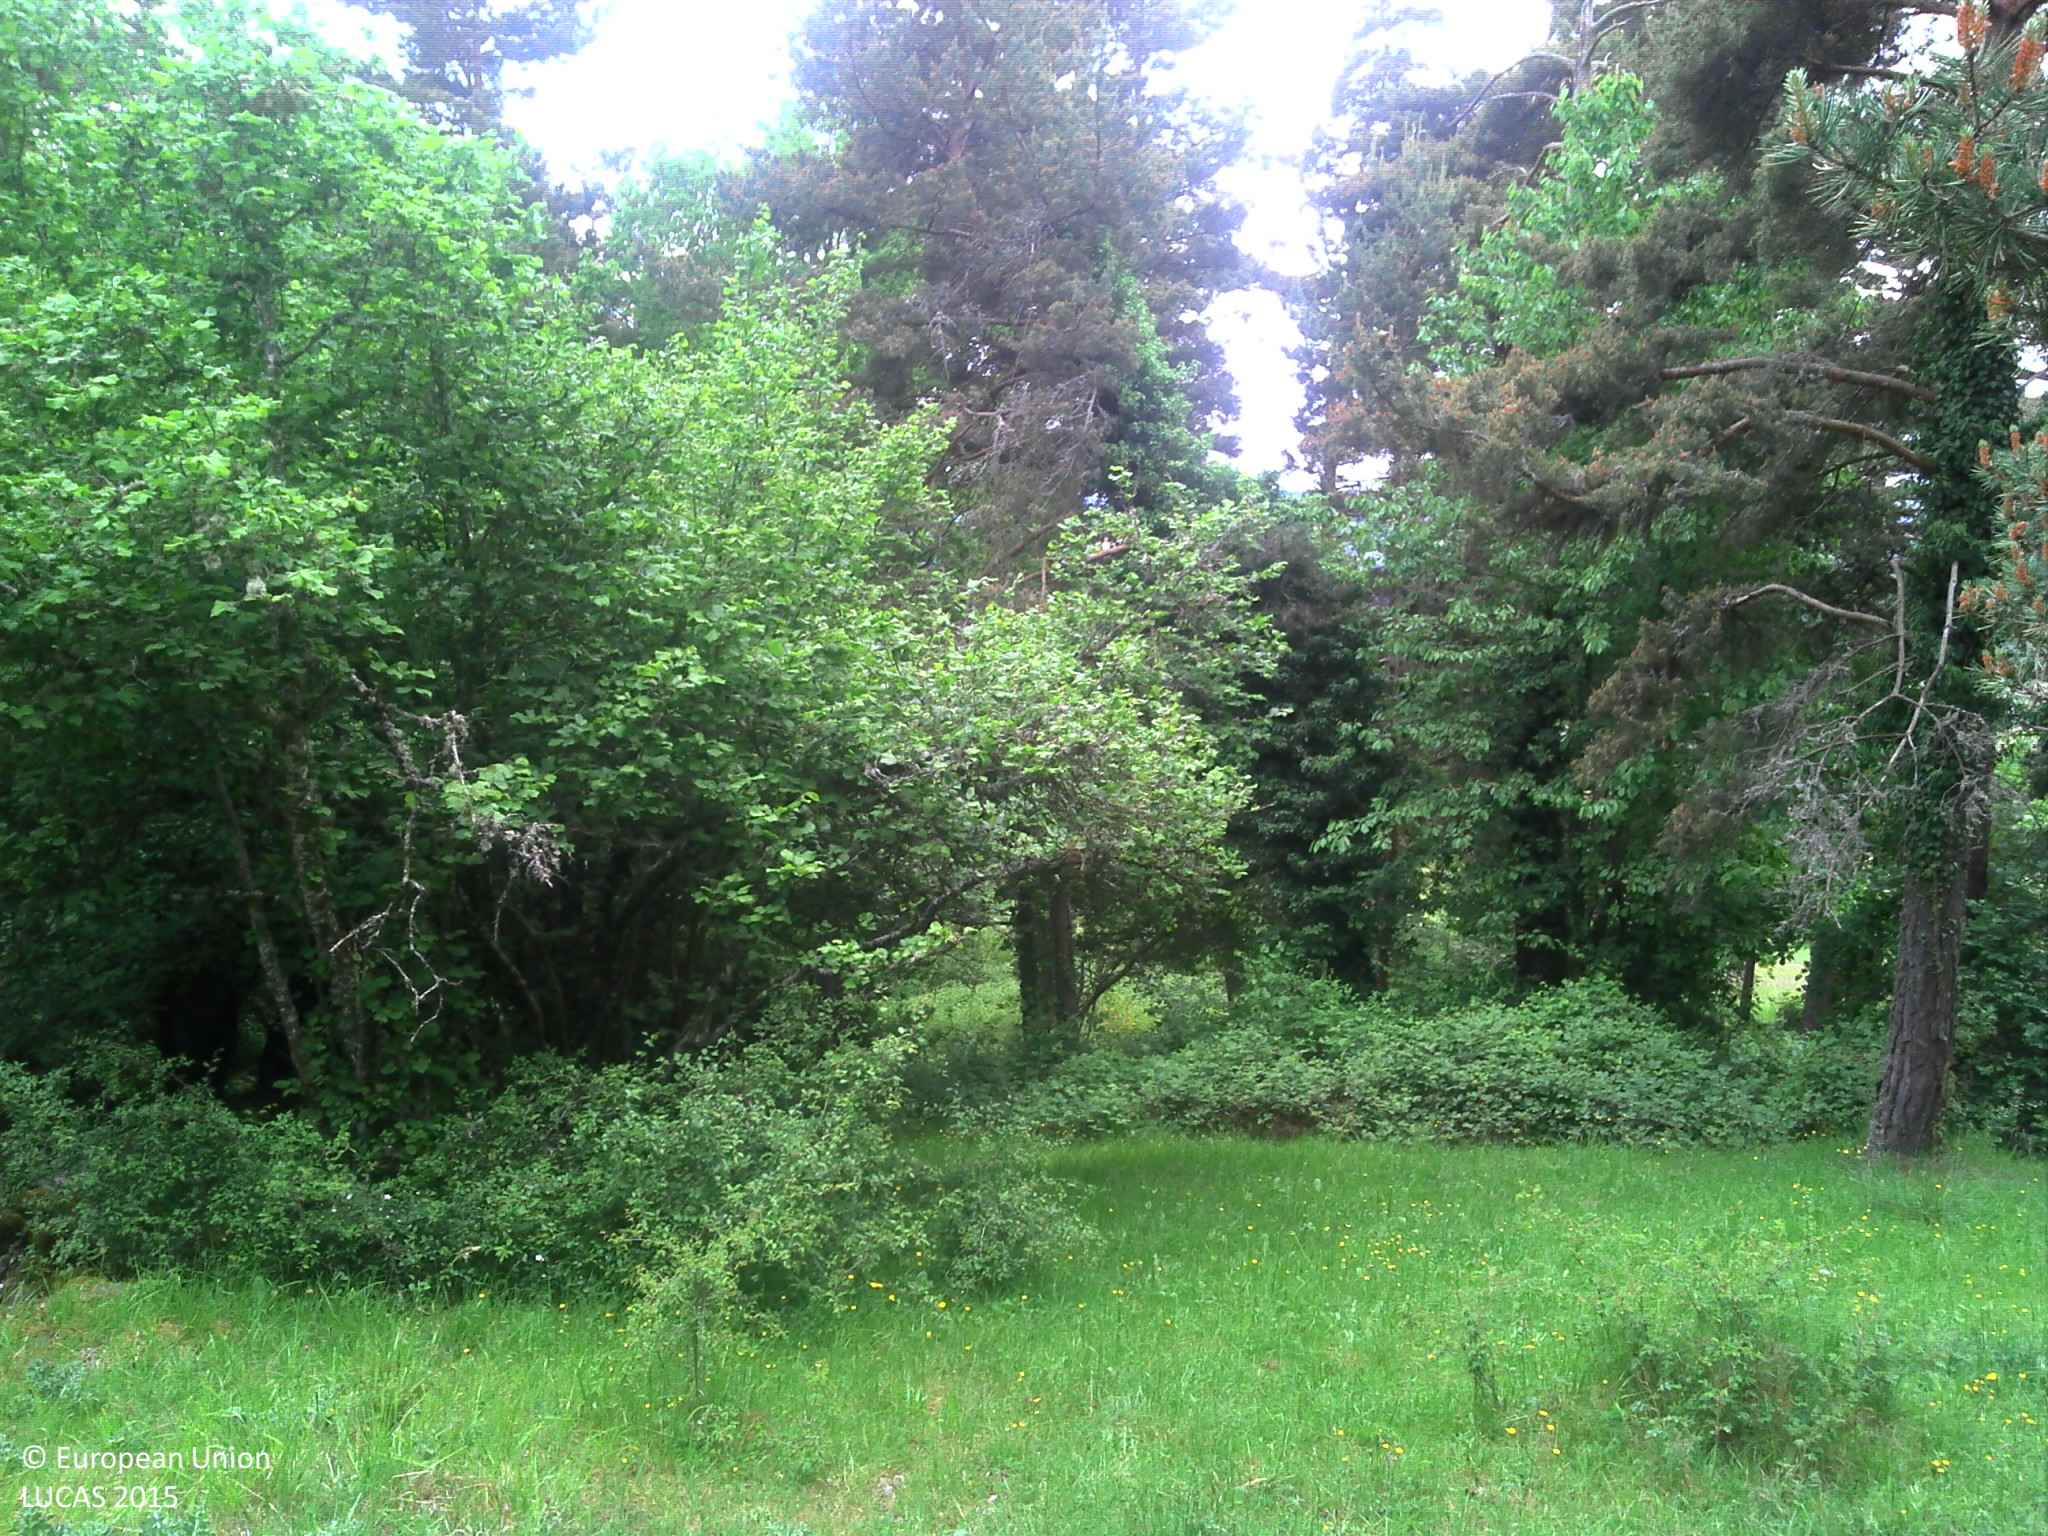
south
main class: Woodland
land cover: Pine dominated mixed woodland
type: alpine coniferous forest
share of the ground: 50 - 75 %
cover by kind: coniferous forest trees 50 %, broadleaved forest trees 20 %, herbaceous plants 20 %, shrubs 10 %
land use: Forestry
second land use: Agriculture (excluding fallow land and kitchen gardens)
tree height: > 5 m
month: June
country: FR
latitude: 45.0457
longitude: 3.1338
